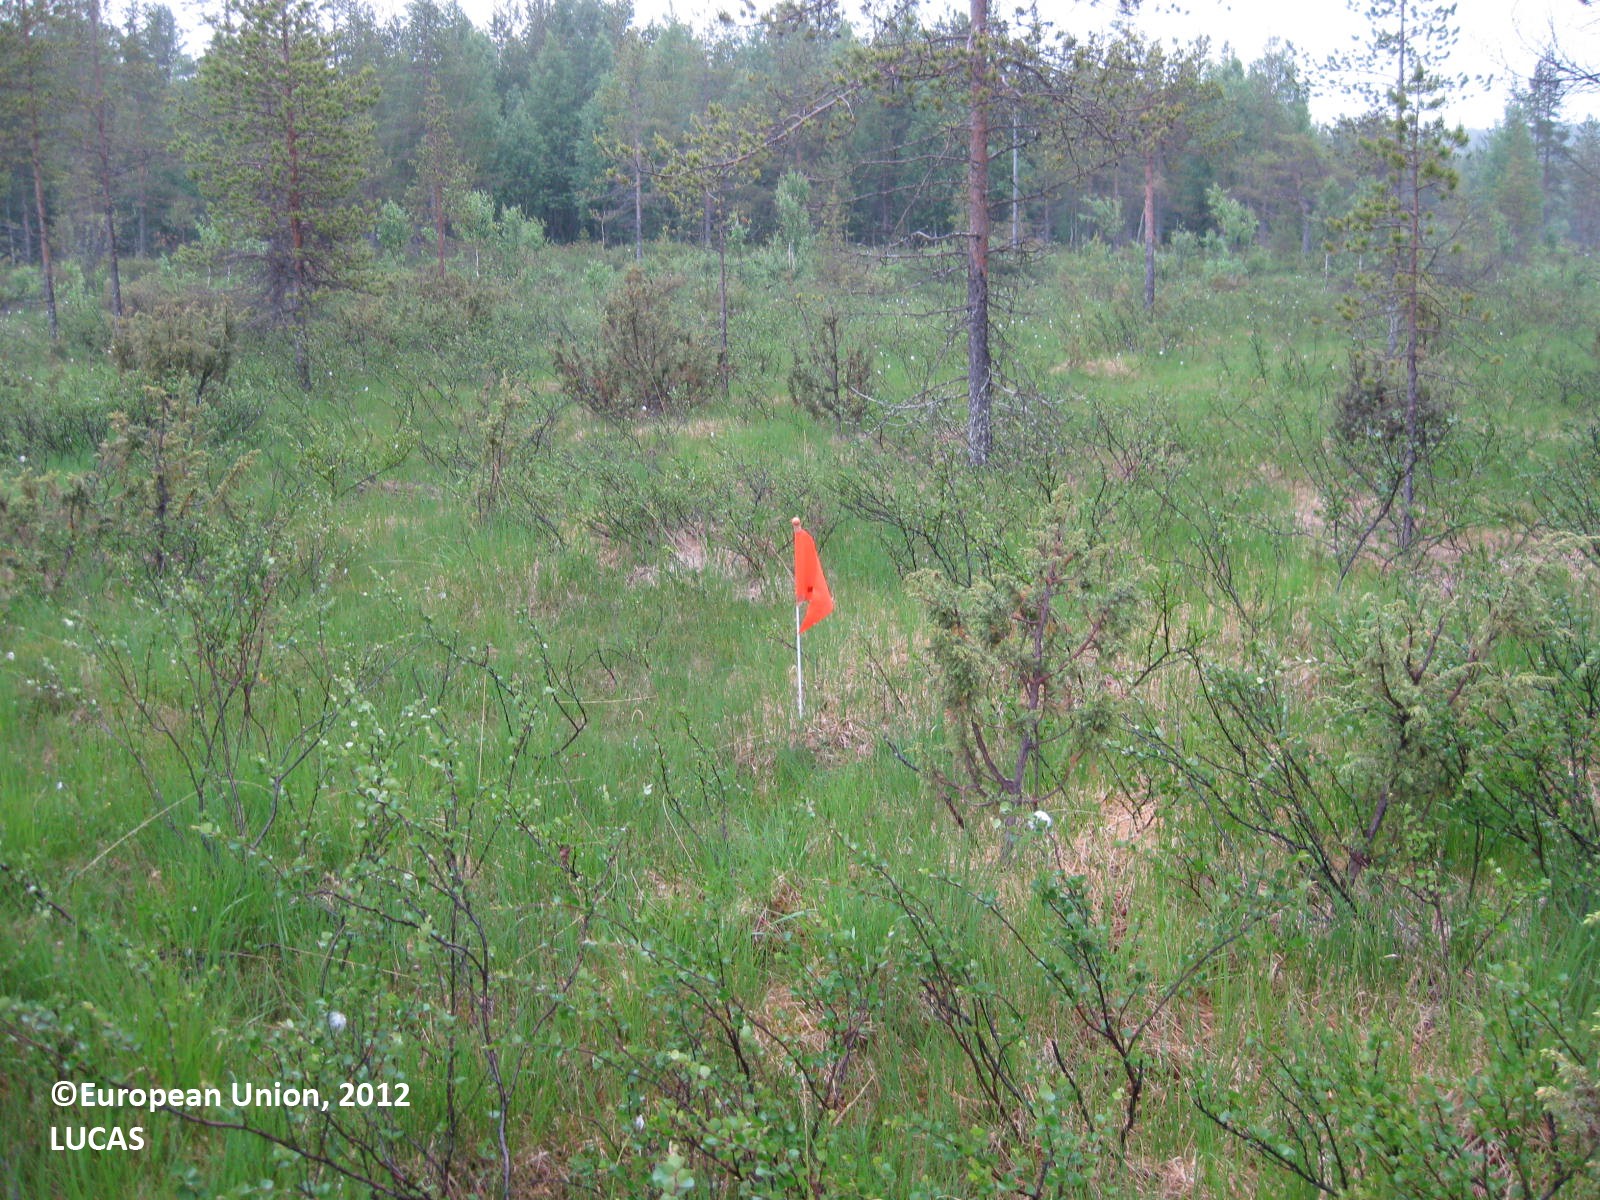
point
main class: Woodland
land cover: Pine dominated coniferous woodland
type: boreal forest
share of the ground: 25 - 50 %
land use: Forestry
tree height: > 5 m
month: July
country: FI
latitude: 65.6479
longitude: 29.4733
